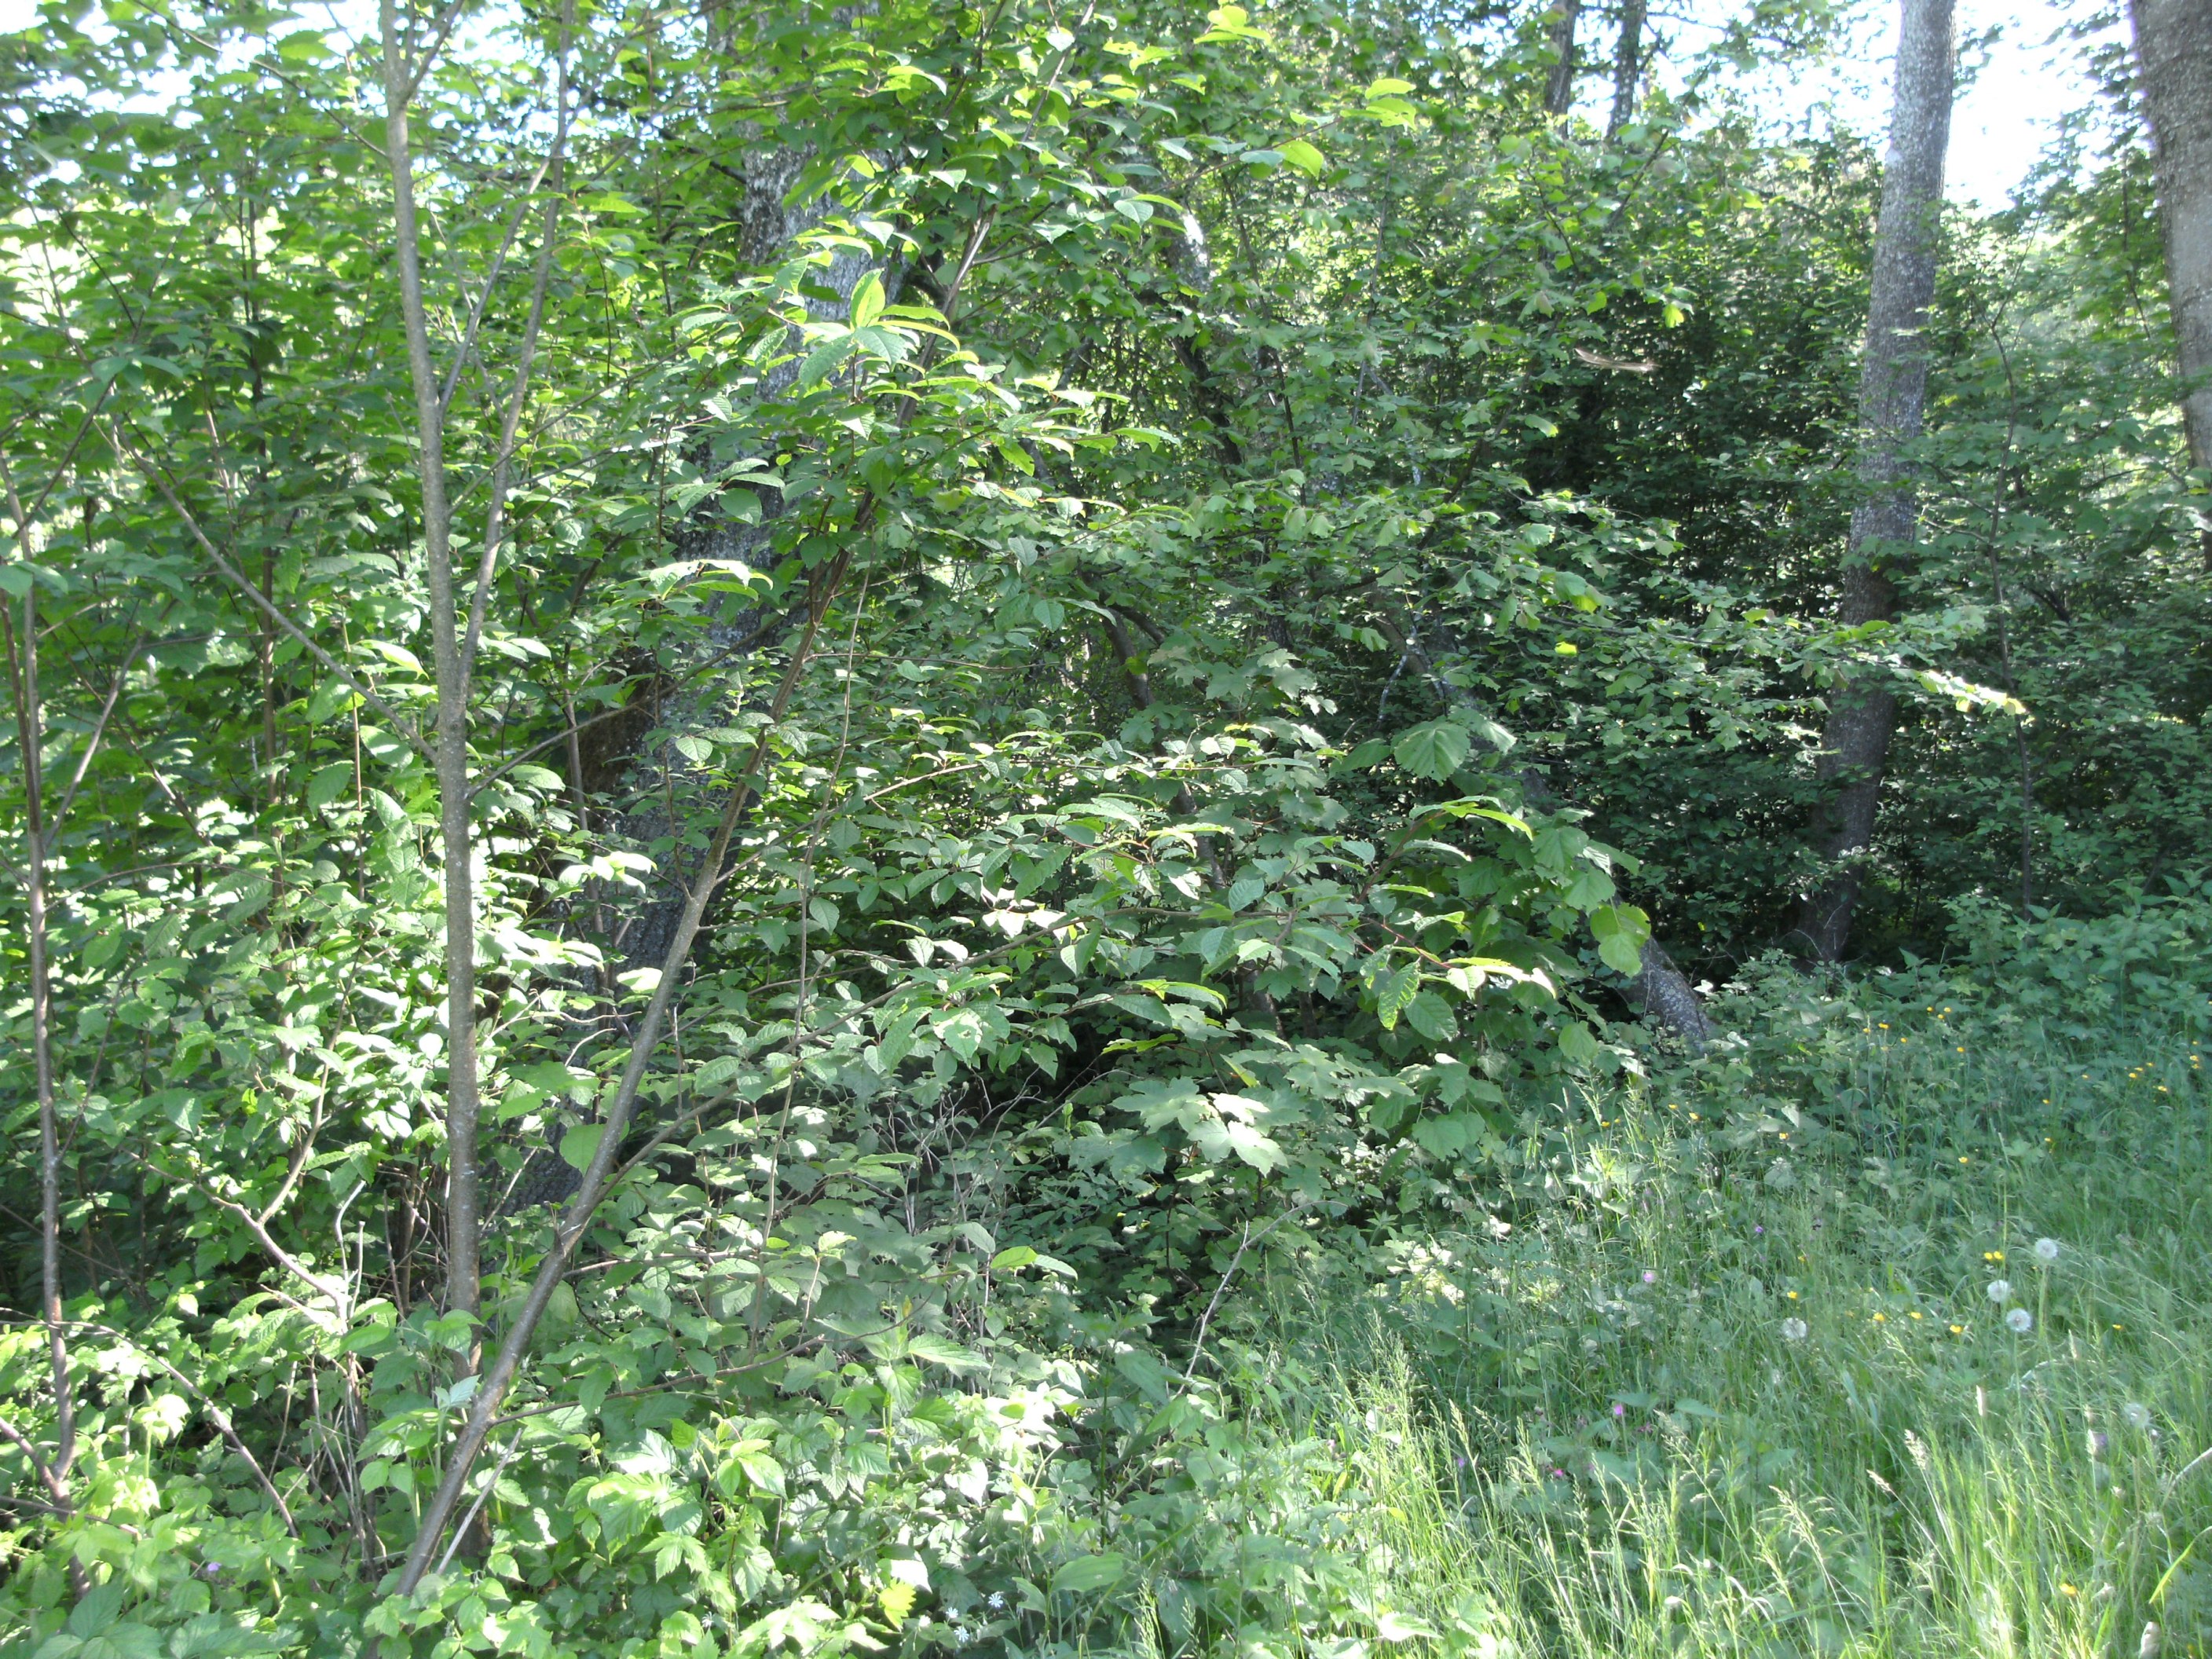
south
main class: Grassland
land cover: Grassland without tree/shrub cover
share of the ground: > 75 %
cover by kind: herbaceous plants 100 %
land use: Agriculture (excluding fallow land and kitchen gardens)
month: May
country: AT
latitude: 48.1454
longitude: 13.6416
